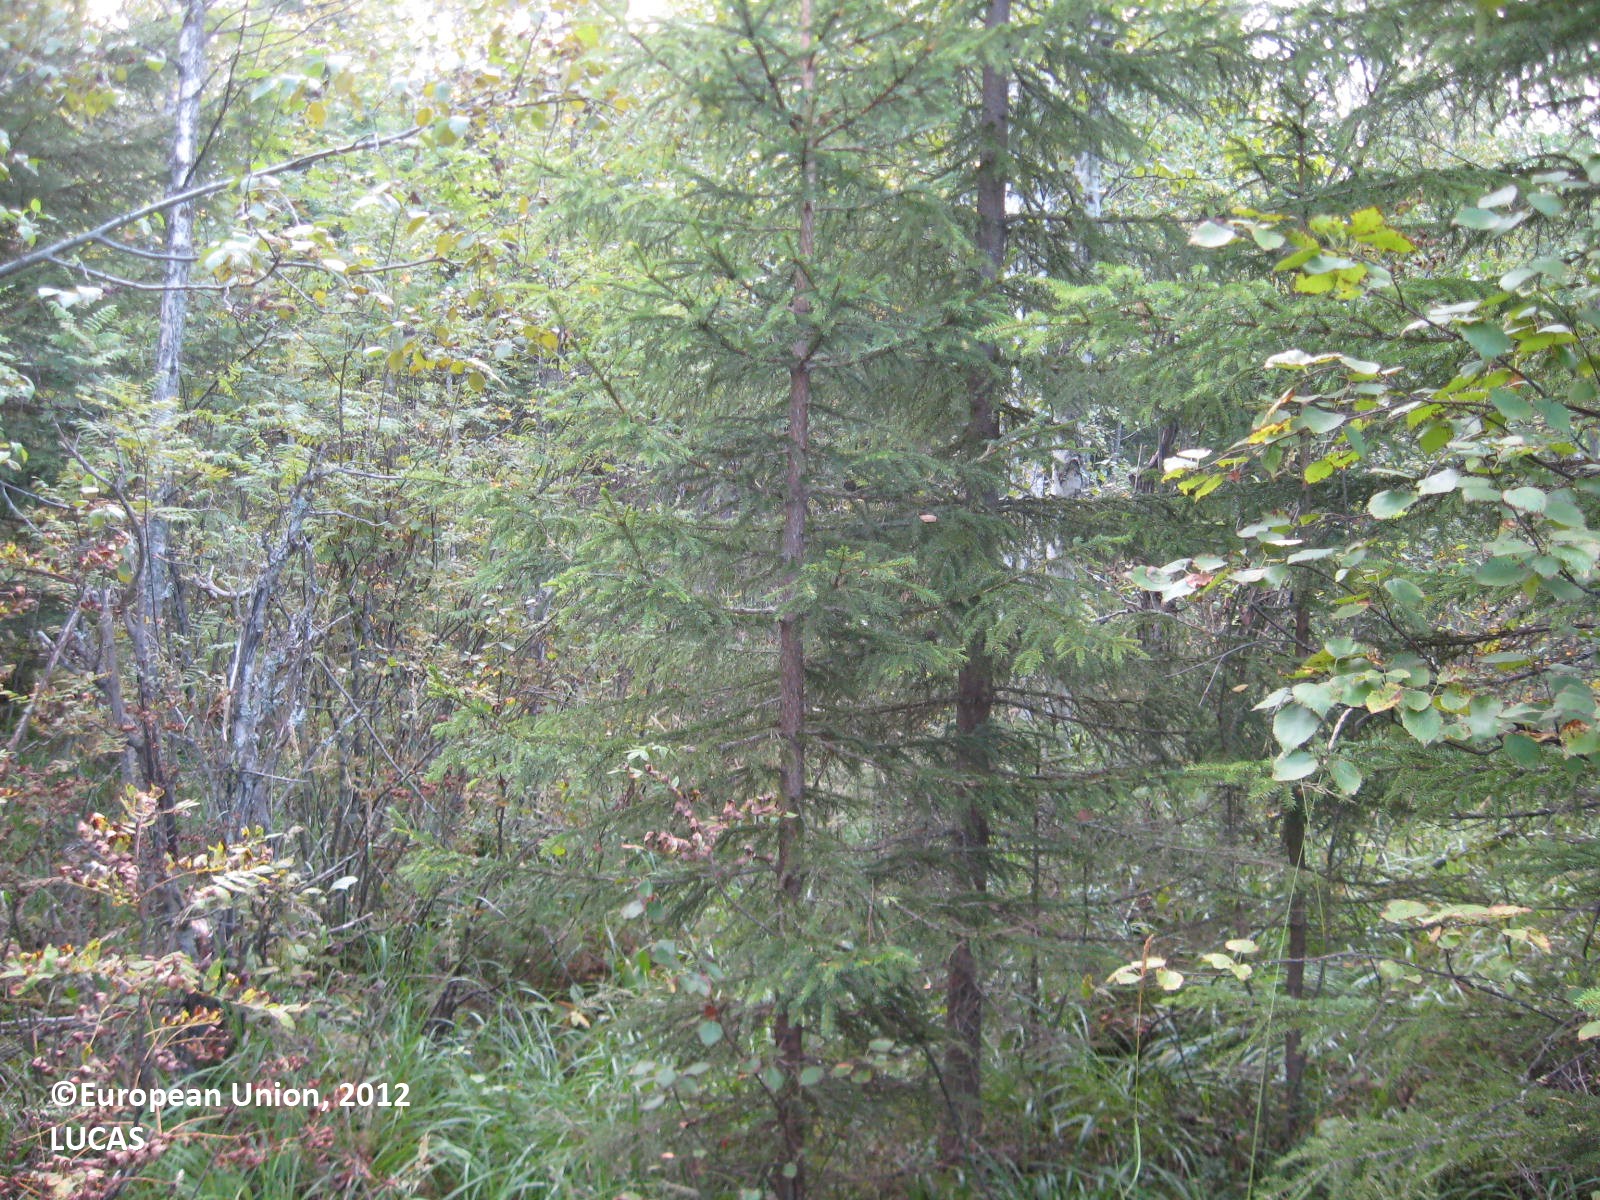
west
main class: Woodland
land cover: Other mixed woodland
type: boreal forest
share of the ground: > 75 %
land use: Forestry
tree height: > 5 m
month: August
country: FI
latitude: 63.5959
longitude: 29.8095
